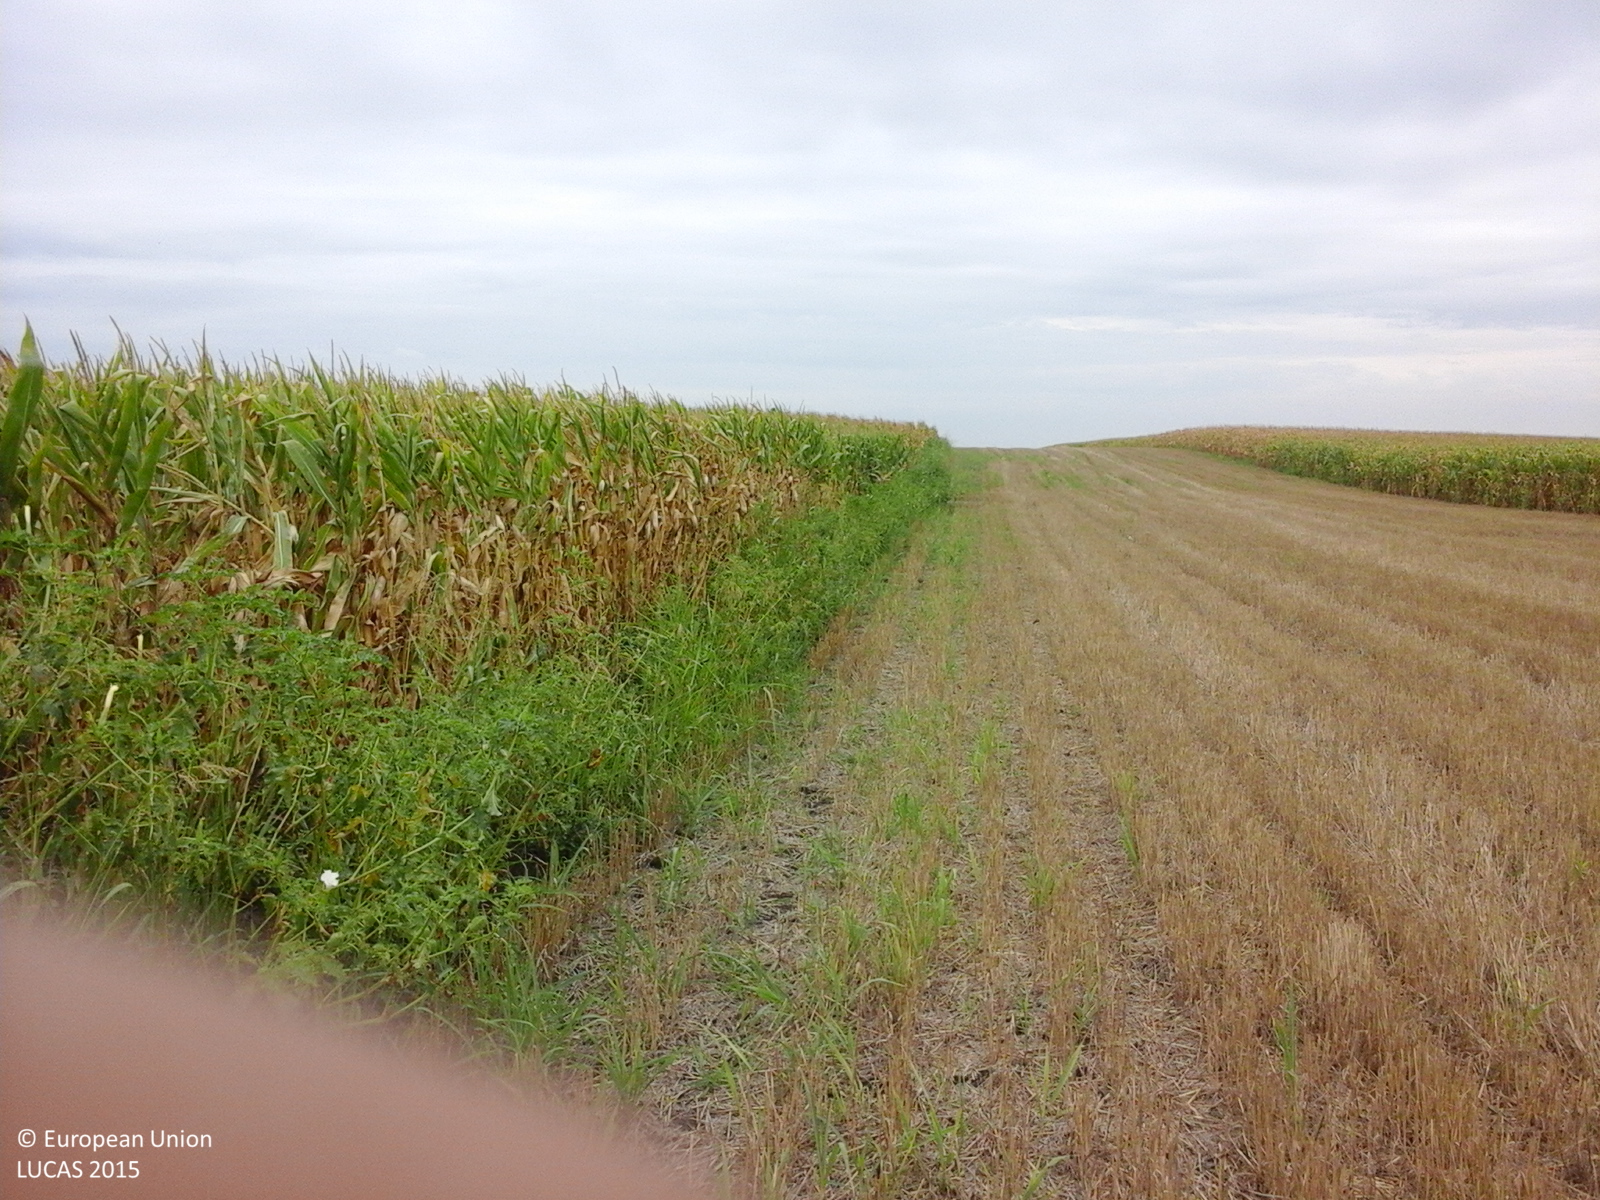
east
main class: Cropland
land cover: Maize
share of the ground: > 75 %
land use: Agriculture (excluding fallow land and kitchen gardens)
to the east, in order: Maize; Spontaneously vegetated surfaces; Ditches and canals; Spontaneously vegetated surfaces
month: August
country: RO
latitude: 45.8566
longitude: 20.8064
